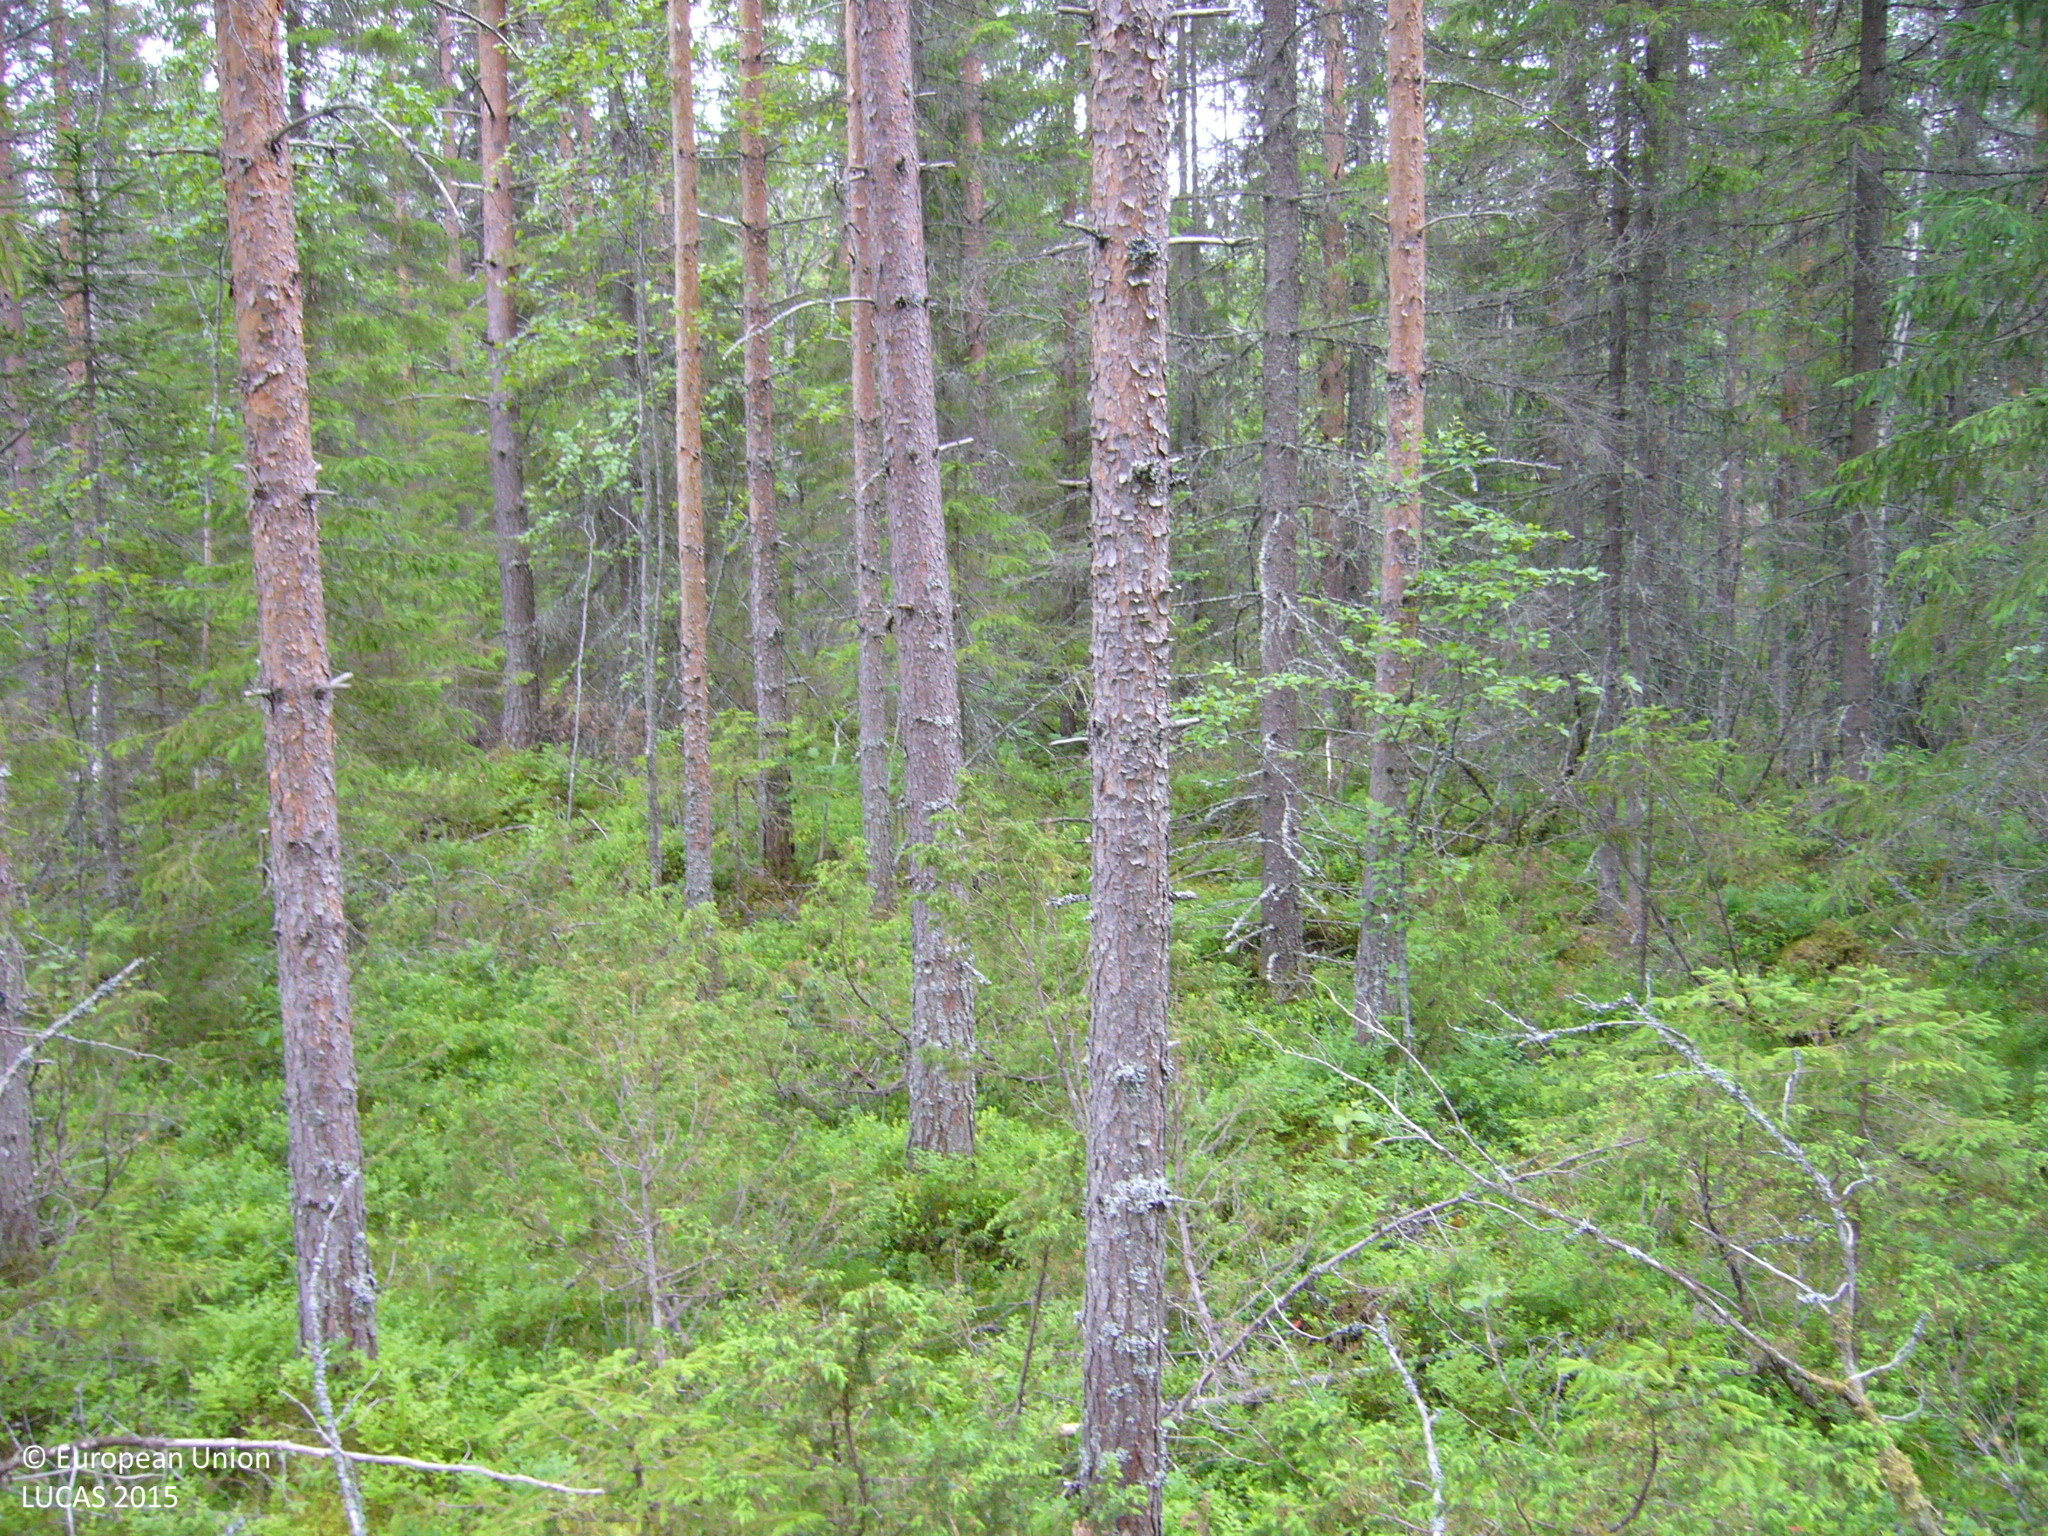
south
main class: Woodland
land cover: Pine dominated coniferous woodland
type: boreal forest
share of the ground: > 75 %
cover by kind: coniferous forest trees 70 %, shrubs 20 %, broadleaved forest trees 10 %
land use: Forestry
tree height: > 5 m
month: July
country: FI
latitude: 63.2910
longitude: 26.0920
